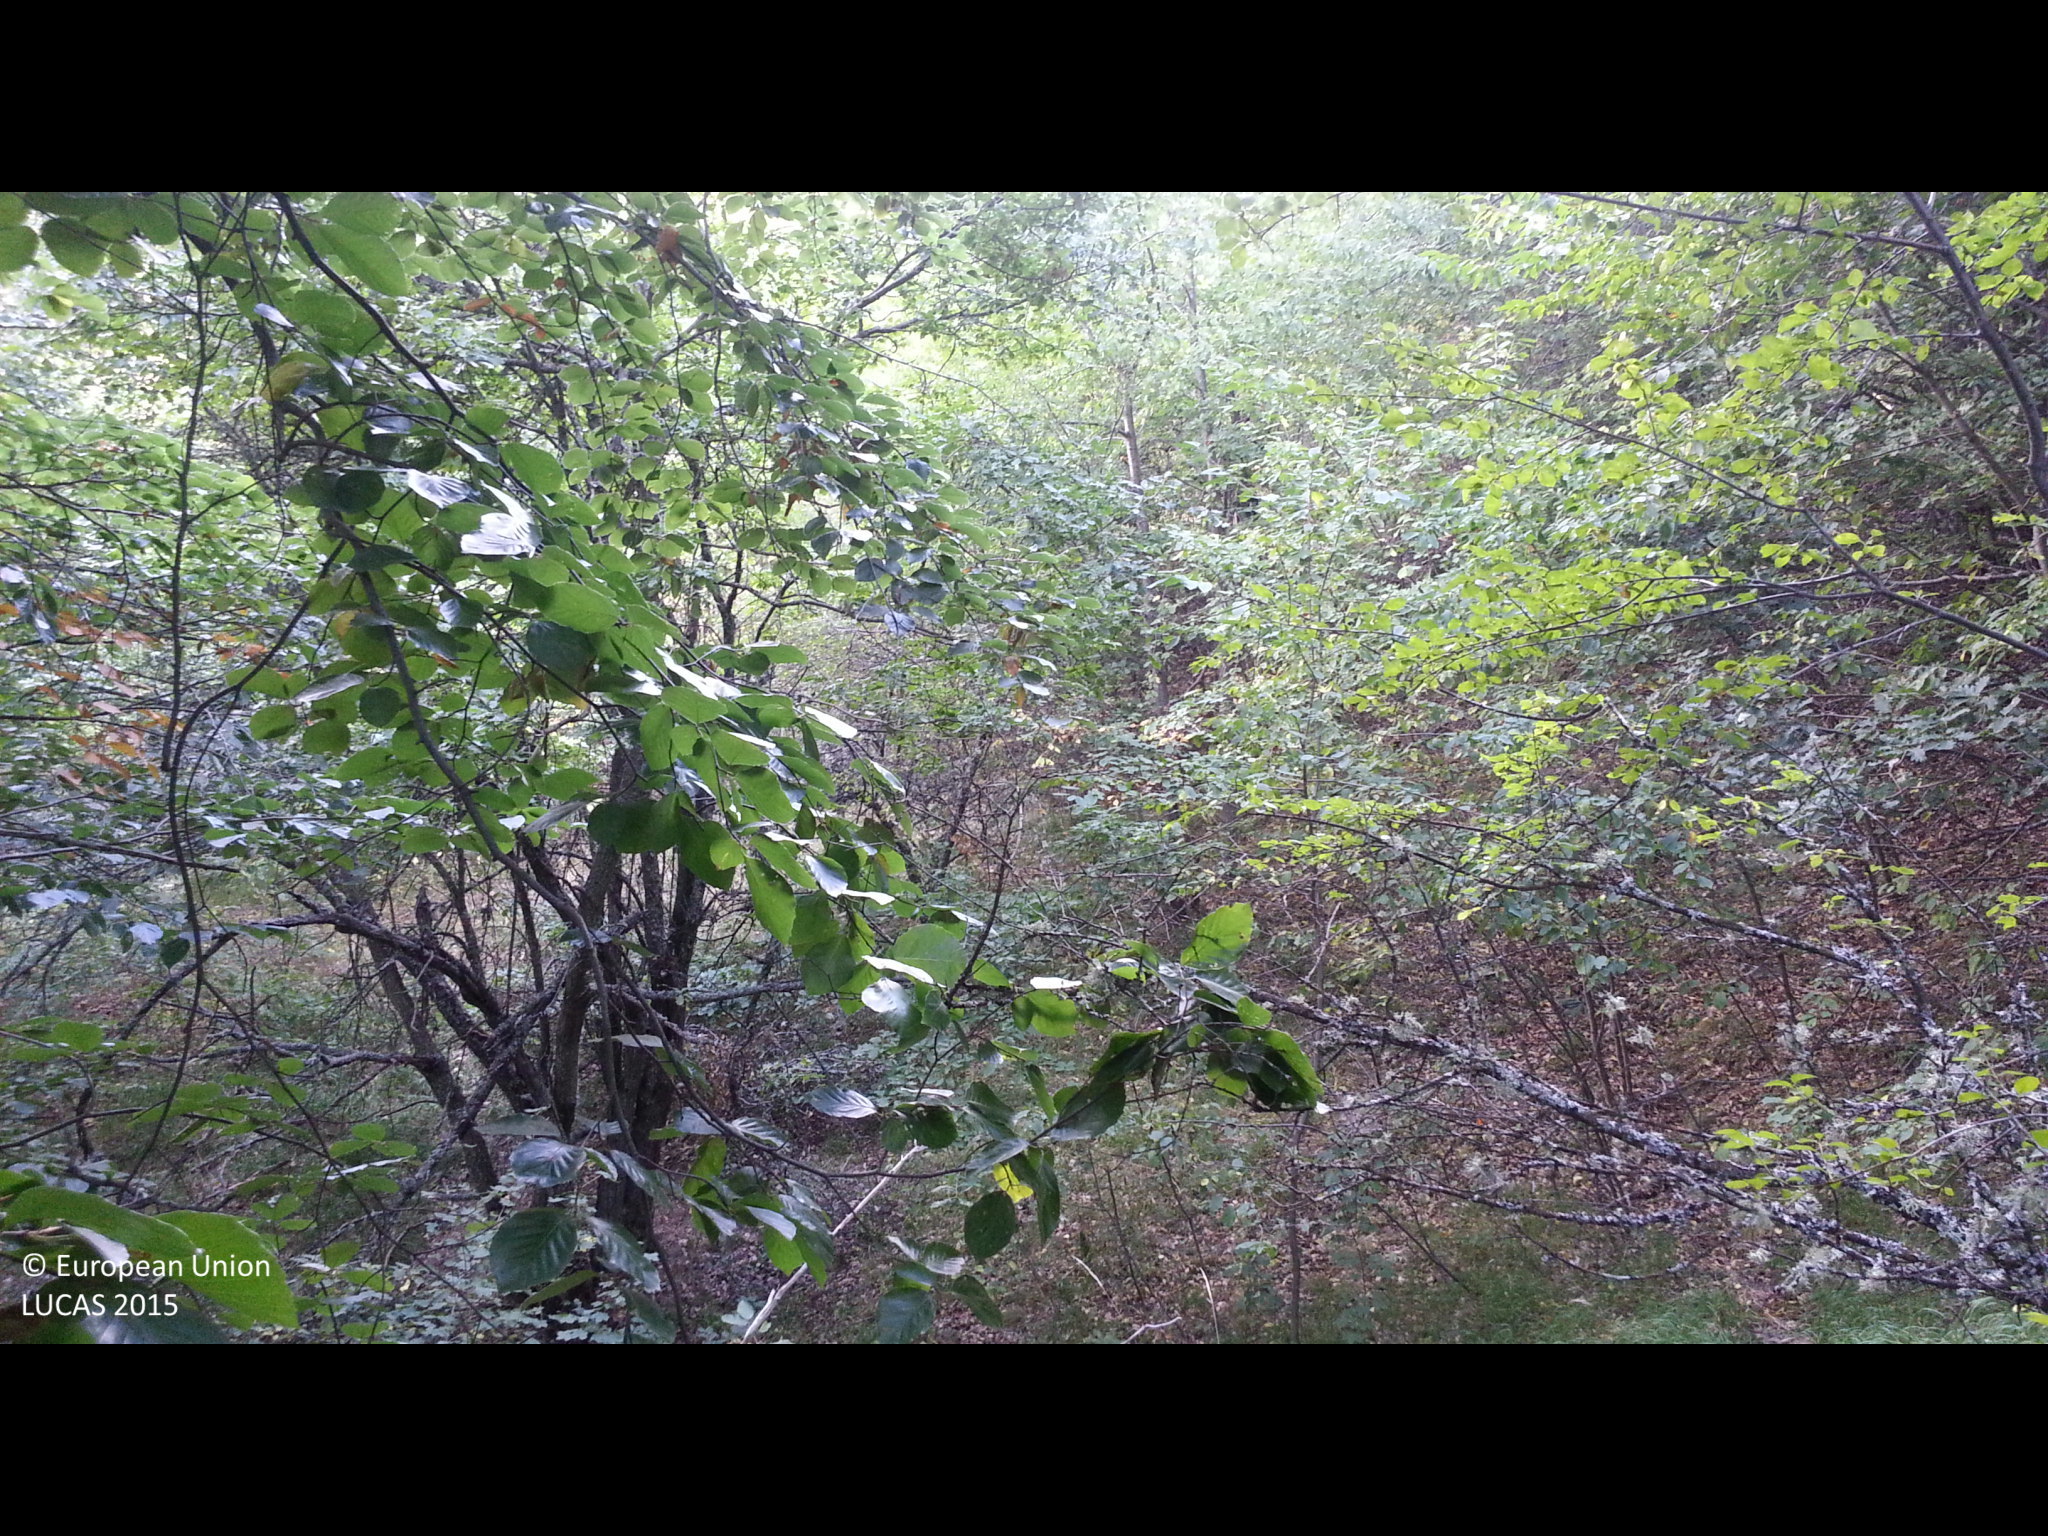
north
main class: Woodland
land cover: Broadleaved woodland
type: mesophytic deciduous forest
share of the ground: > 75 %
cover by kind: broadleaved forest trees 85 %, herbaceous plants 10 %, shrubs 5 %
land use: Forestry
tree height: > 5 m
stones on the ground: < 10 %
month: September
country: BG
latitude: 42.3287
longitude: 22.5319
